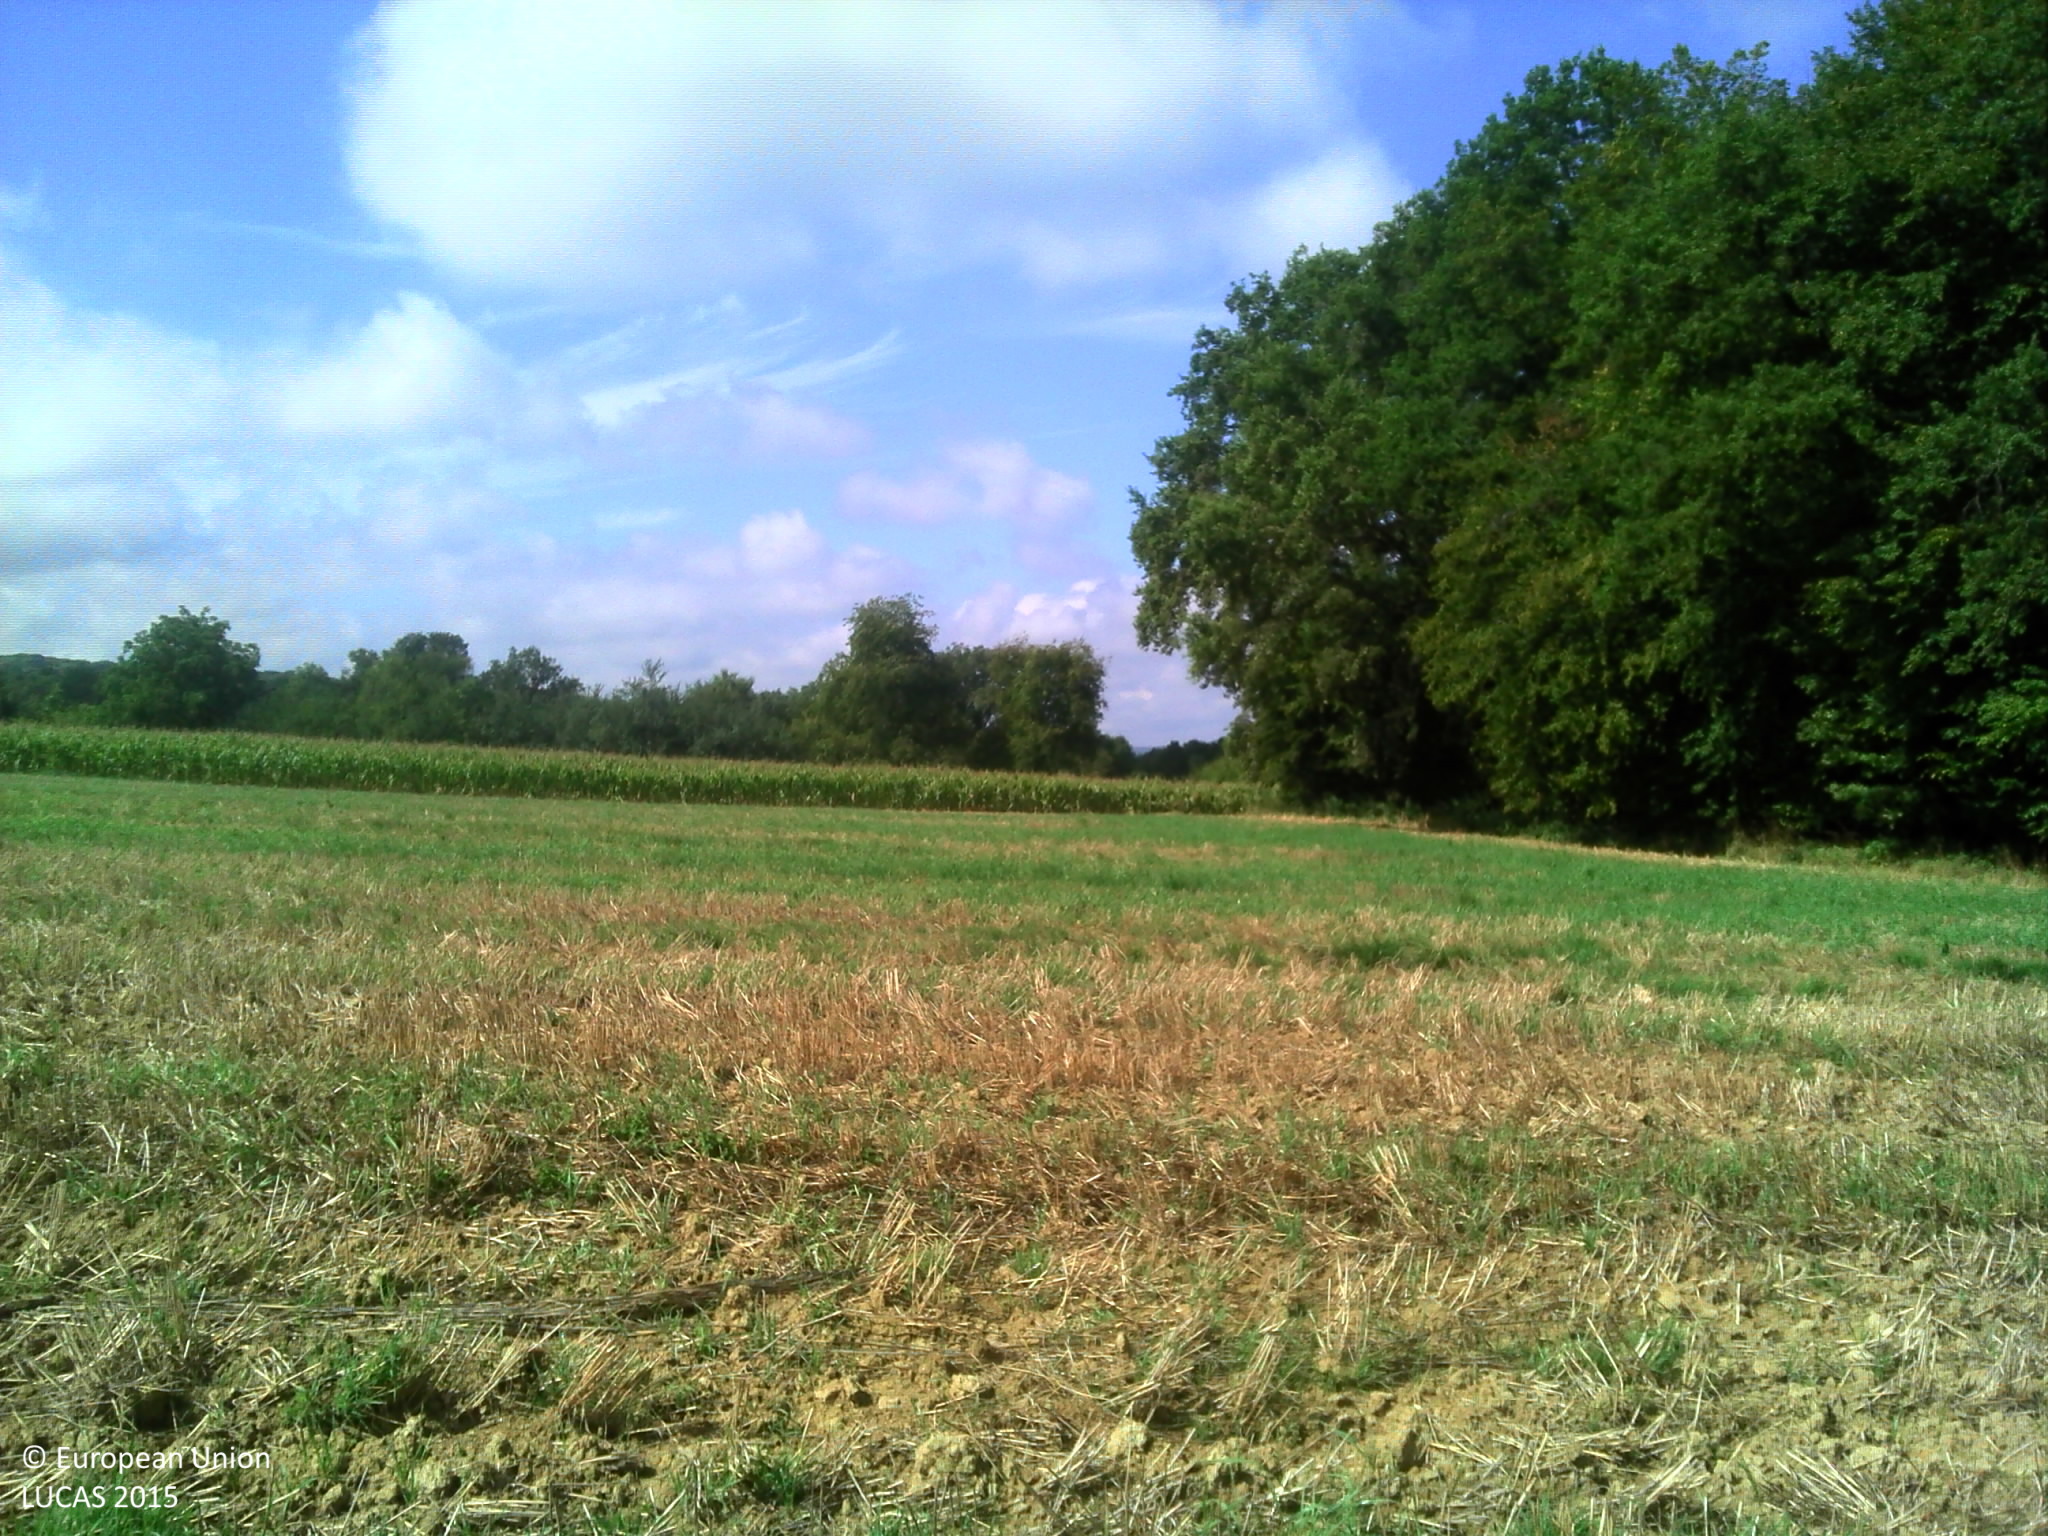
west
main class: Cropland
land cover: Common wheat
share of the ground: 50 - 75 %
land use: Agriculture (excluding fallow land and kitchen gardens)
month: September
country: FR
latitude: 47.4591
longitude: 6.8845
